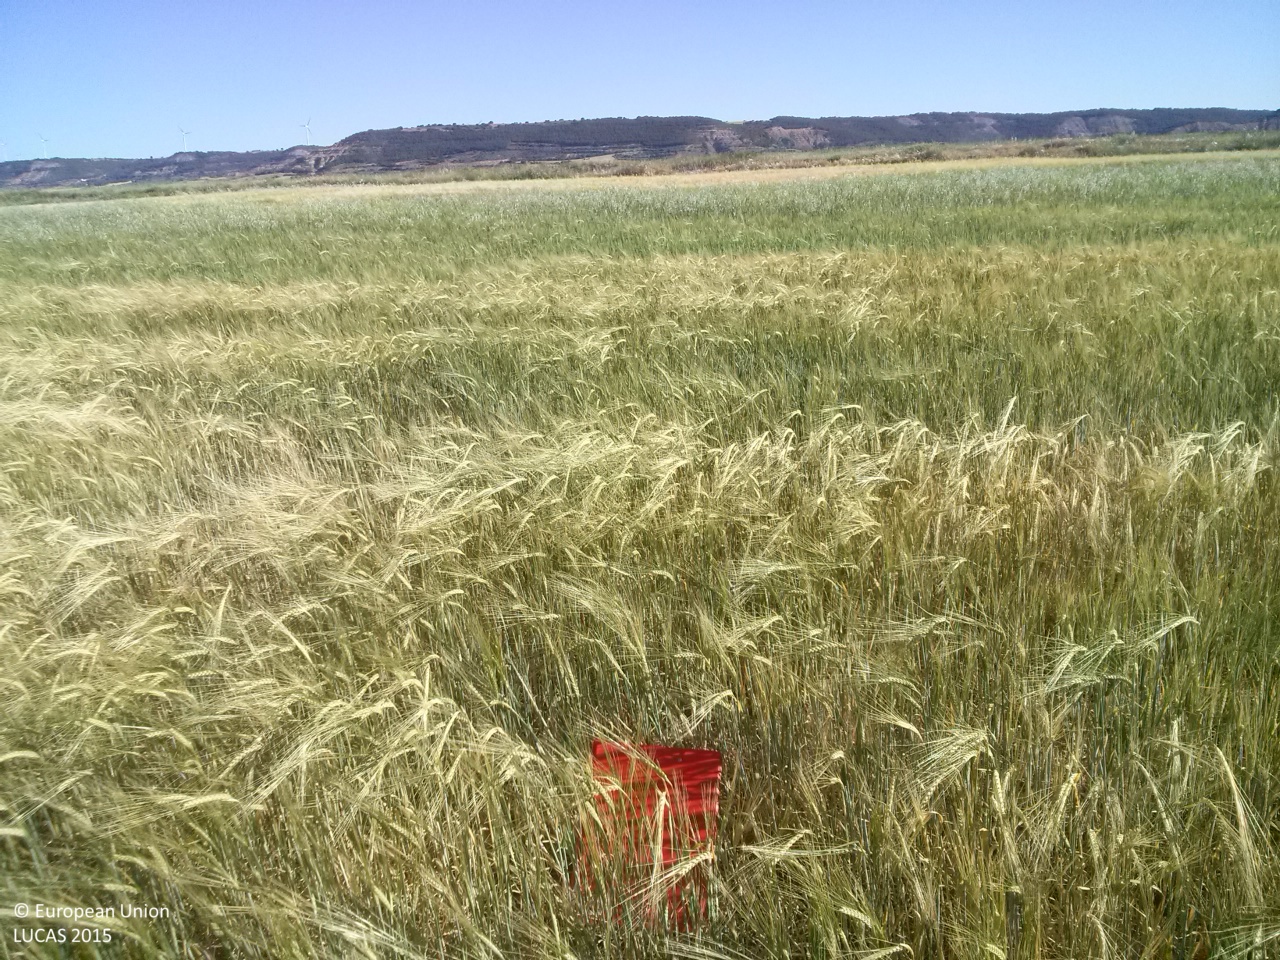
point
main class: Cropland
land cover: Barley
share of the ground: > 75 %
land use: Agriculture (excluding fallow land and kitchen gardens)
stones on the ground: < 10 %
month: May
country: ES
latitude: 40.2988
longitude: -2.5519
